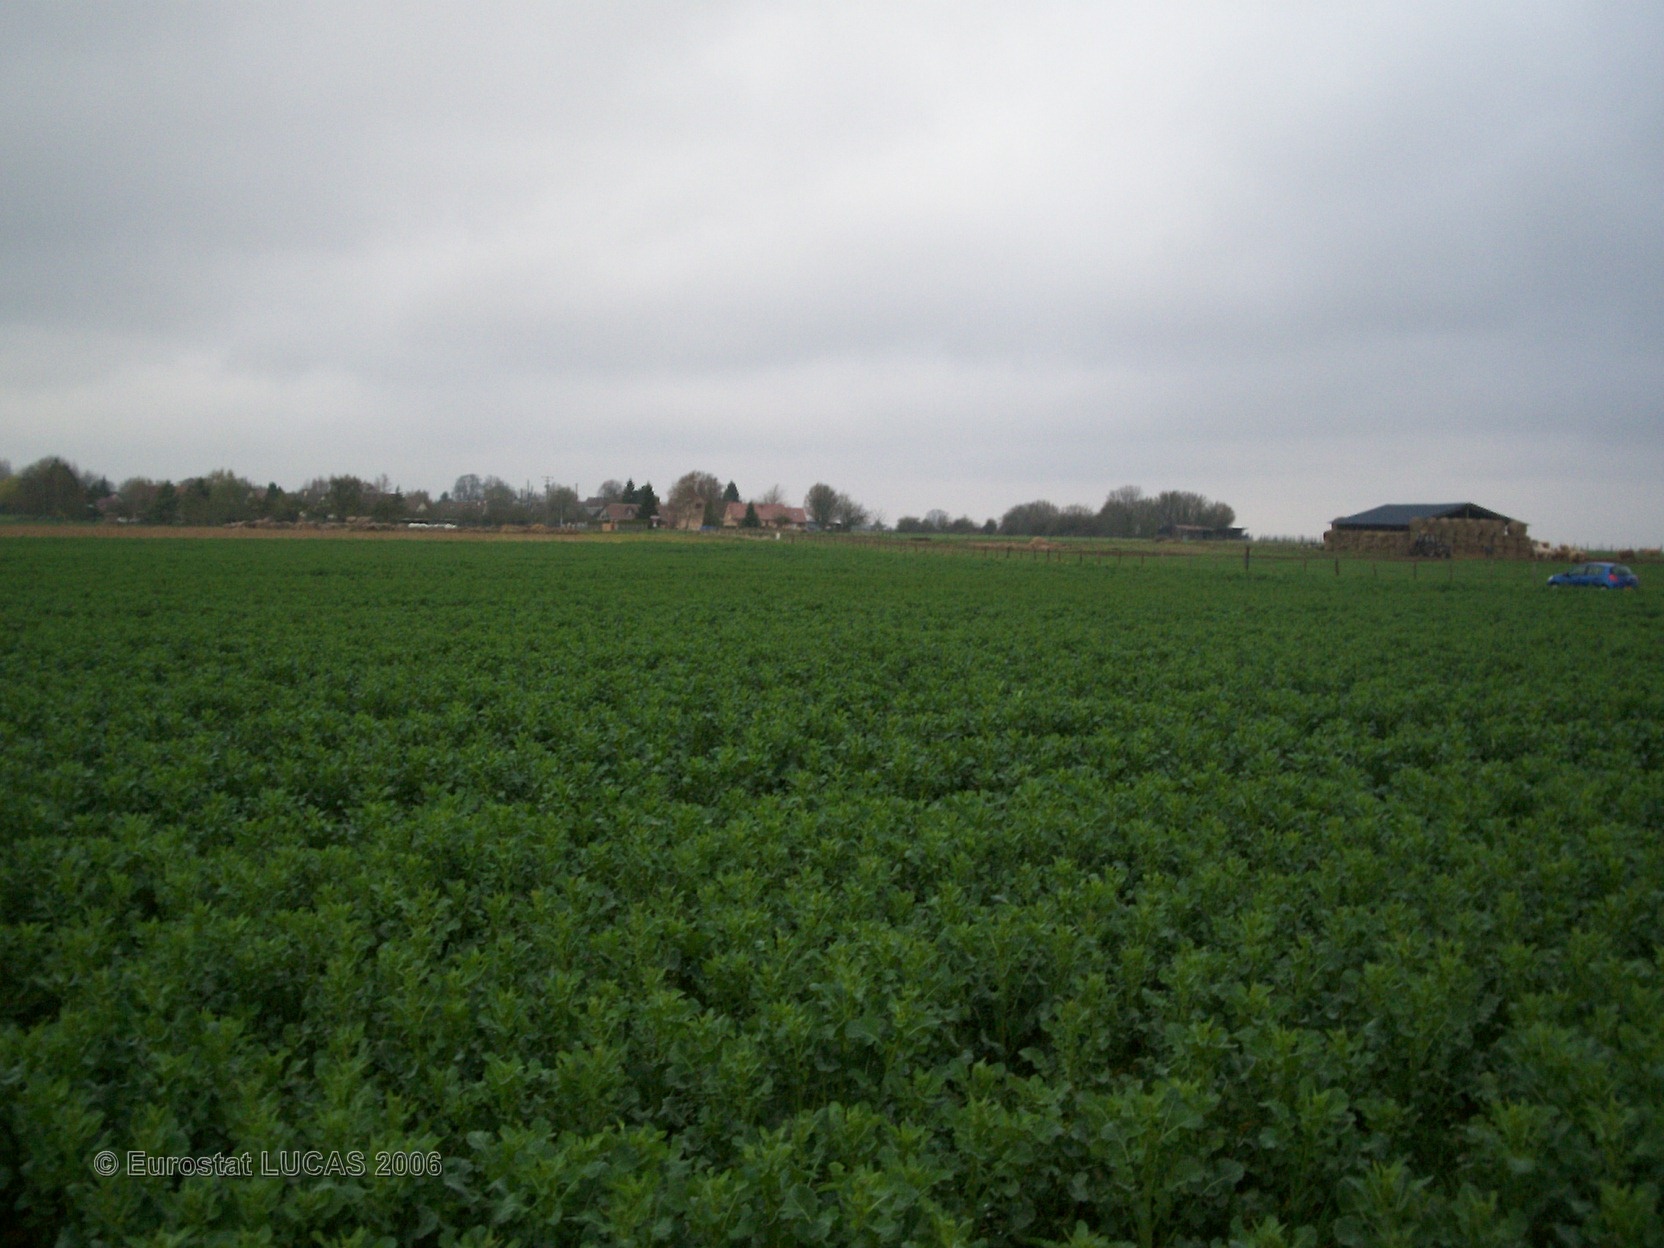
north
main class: Cropland
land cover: Rape and turnip rape
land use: Agriculture (excluding fallow land and kitchen gardens)
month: April
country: FR
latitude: 49.2135
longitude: 1.0139
